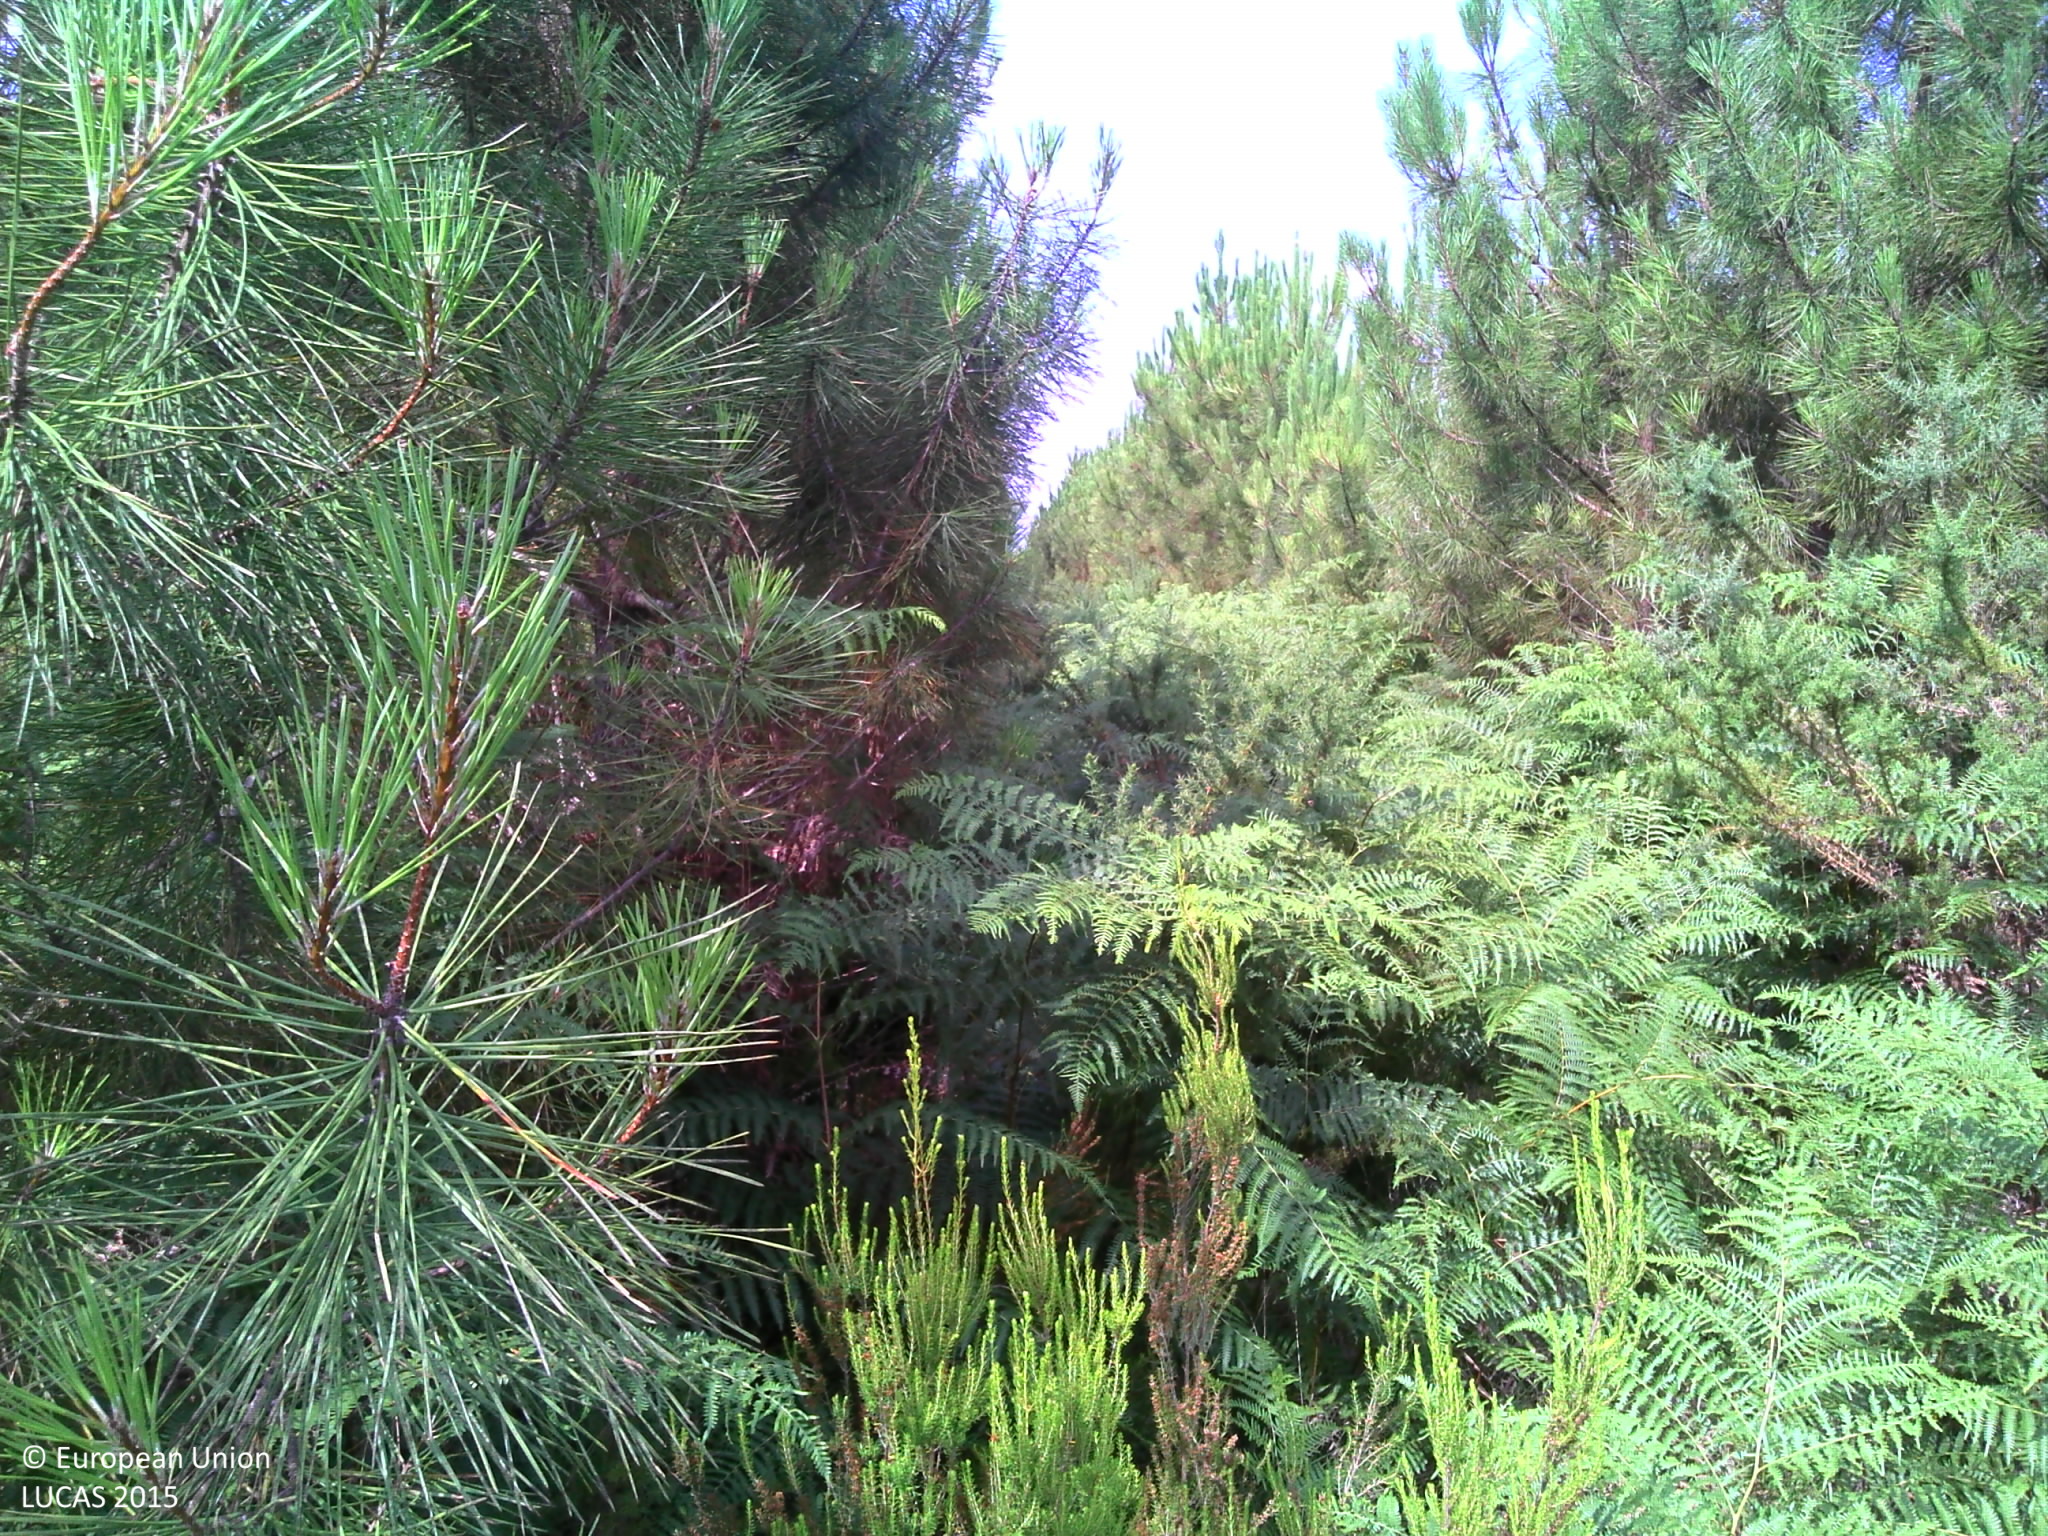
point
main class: Woodland
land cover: Pine dominated coniferous woodland
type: coniferous forest of the mediterranean region
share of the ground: 50 - 75 %
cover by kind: coniferous forest trees 60 %, herbaceous plants 40 %
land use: Forestry
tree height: < 5 m
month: July
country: FR
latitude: 44.1842
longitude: -0.6357
